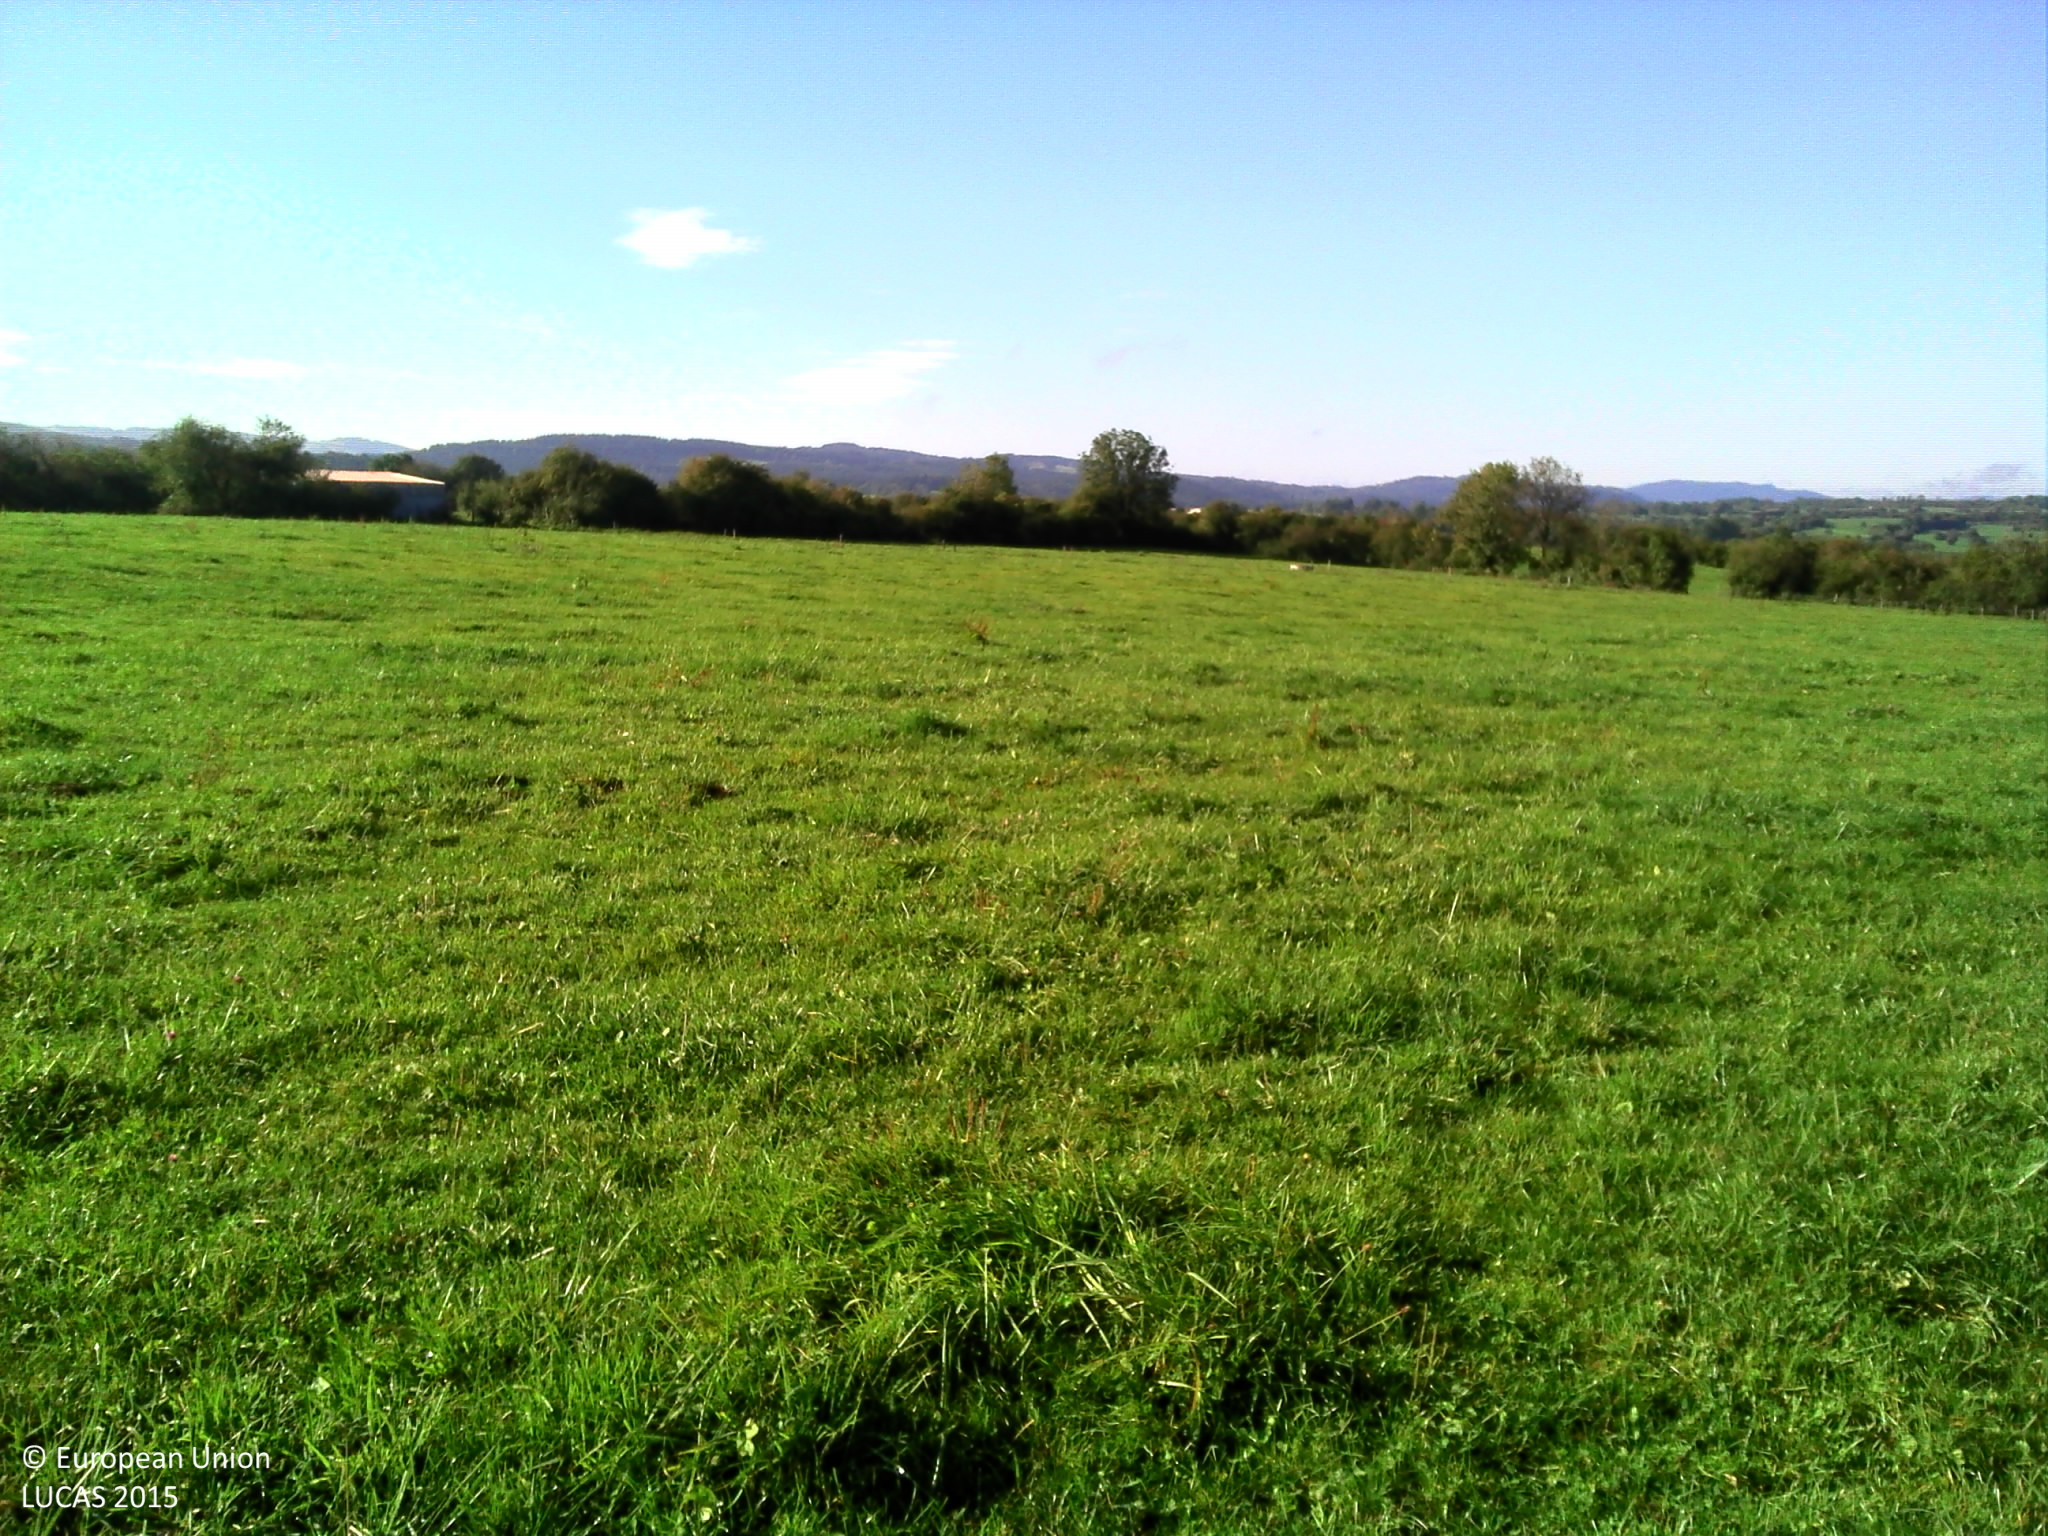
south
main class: Grassland
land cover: Grassland with sparse tree/shrub cover
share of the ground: > 75 %
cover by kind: herbaceous plants 95 %, broadleaved forest trees 5 %
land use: Agriculture (excluding fallow land and kitchen gardens)
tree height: > 5 m
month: September
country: FR
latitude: 47.1182
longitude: 6.3512
